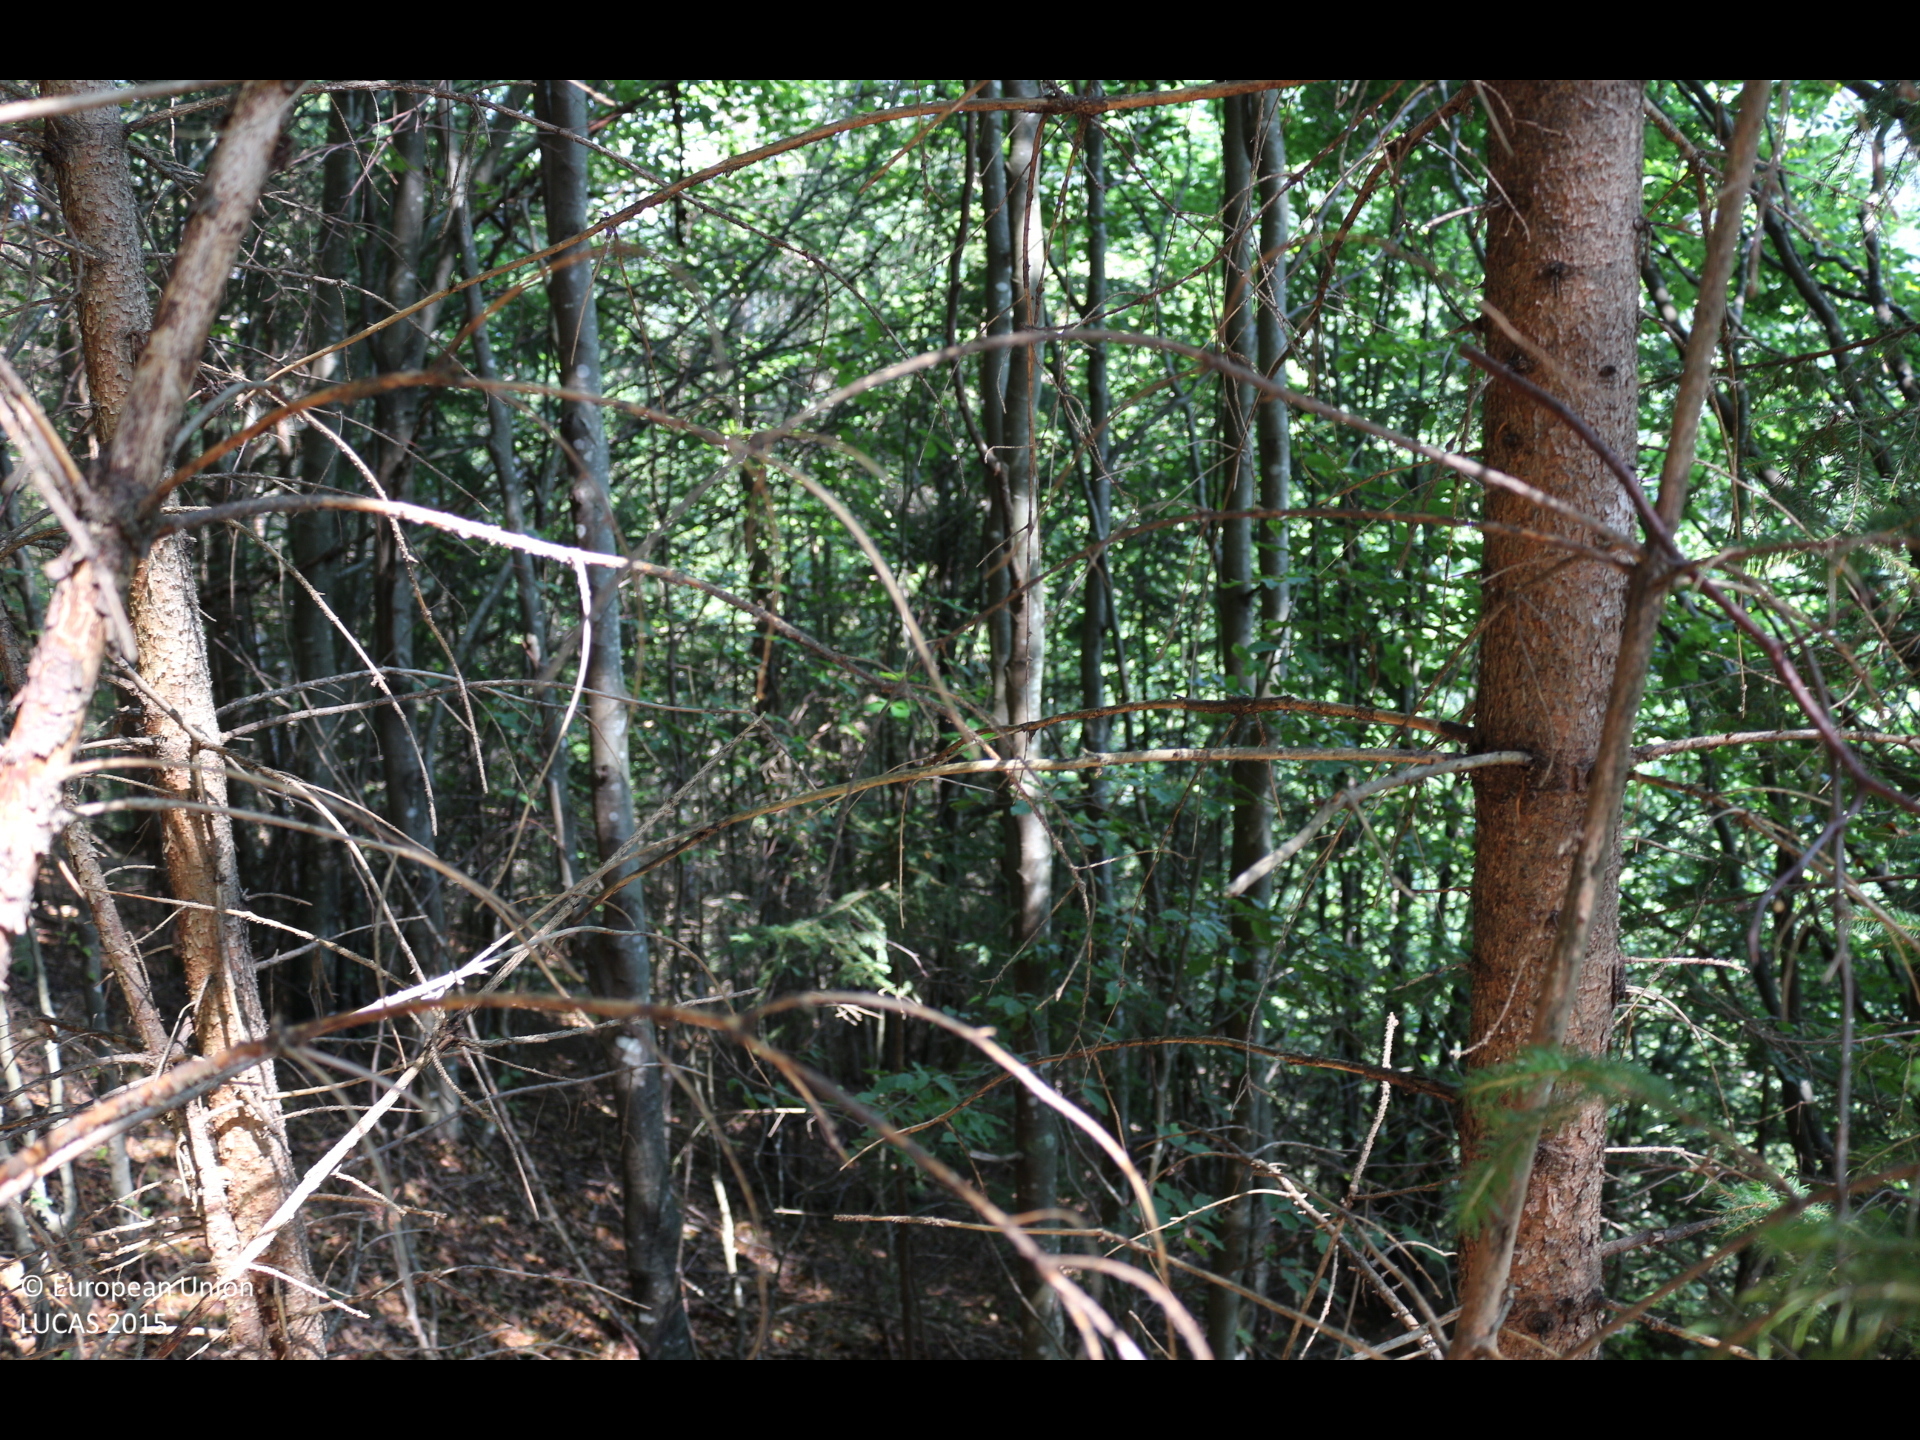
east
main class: Woodland
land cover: Spruce dominated mixed woodland
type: alpine coniferous forest
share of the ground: > 75 %
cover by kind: broadleaved forest trees 60 %, coniferous forest trees 40 %
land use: Forestry
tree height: > 5 m
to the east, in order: Spruce dominated mixed woodland; Spruce dominated coniferous woodland; Artificial constructions in urban areas; Rivers and streams; Spruce dominated coniferous woodland; Grass margins; Artificial constructions in urban areas; Broadleaved woodland; Rivers and streams; Spruce dominated mixed woodland; Rivers and streams; Spruce dominated mixed woodland; Grassland without tree/shrub cover
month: August
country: AT
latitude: 46.8156
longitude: 14.0474
